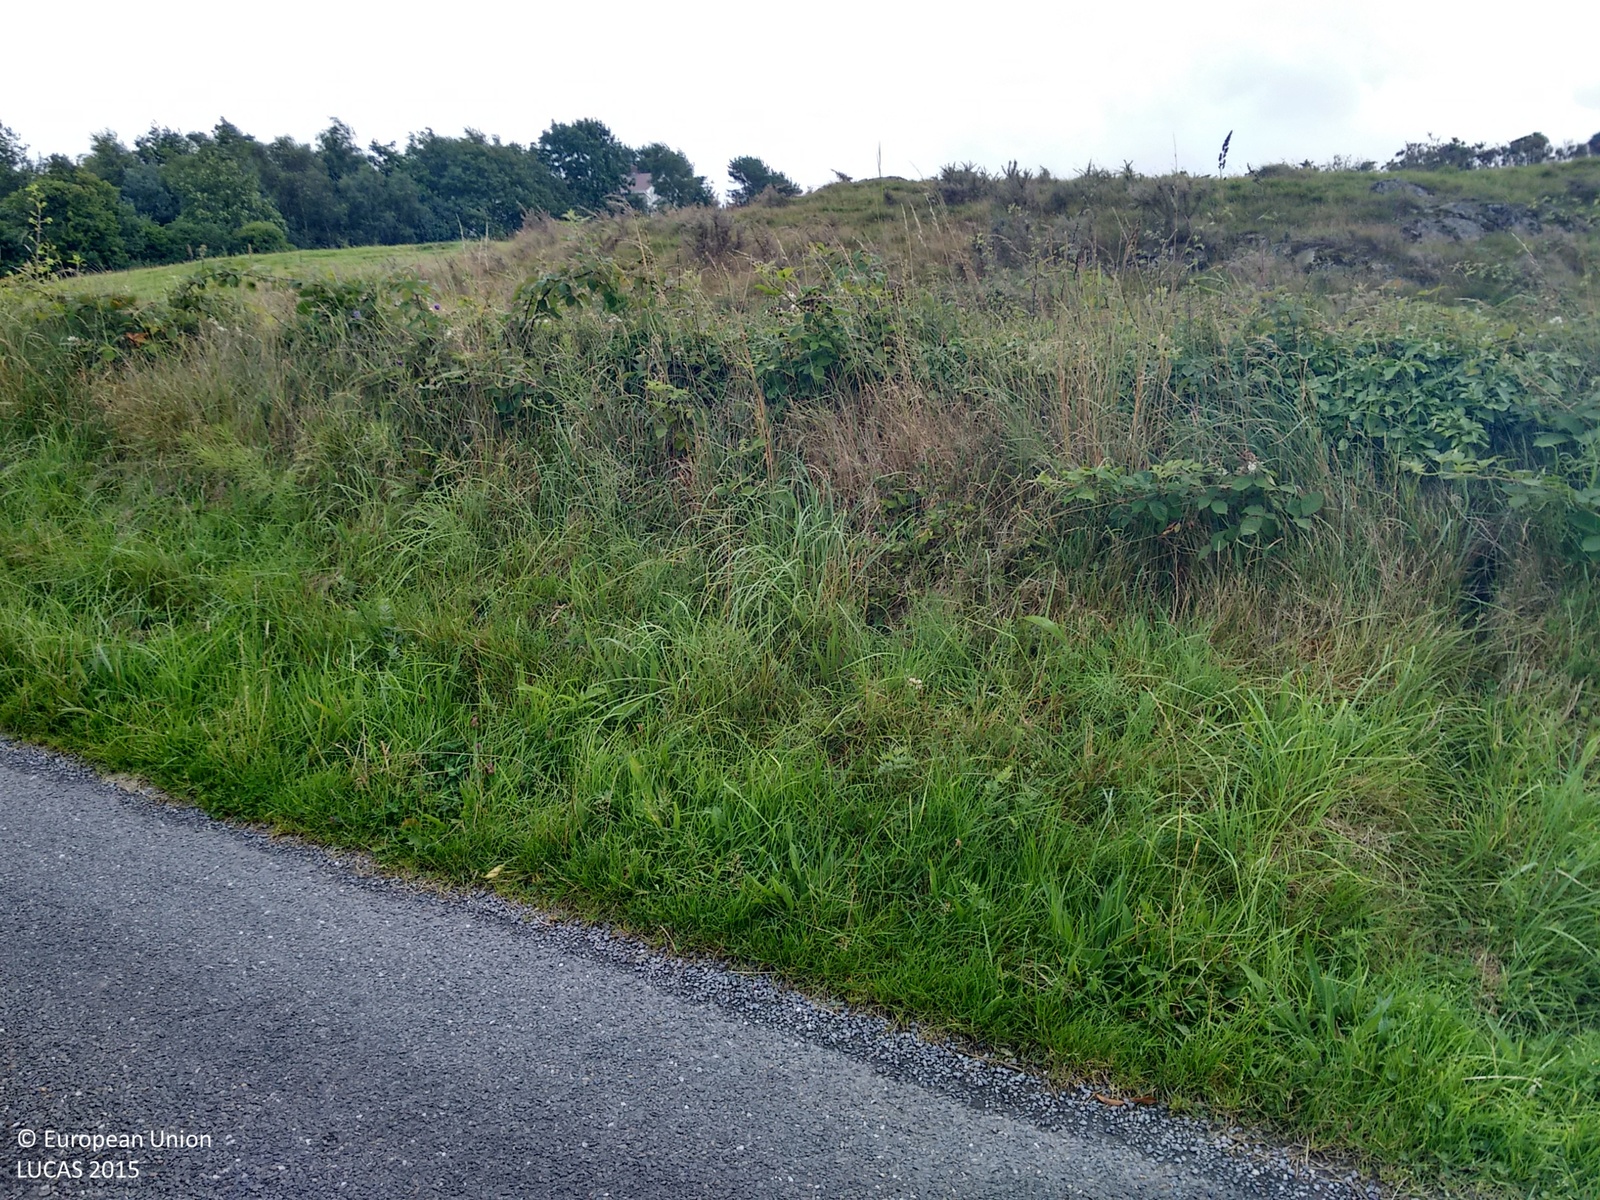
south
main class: Grassland
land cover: Grassland without tree/shrub cover
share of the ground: > 75 %
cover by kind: herbaceous plants 100 %
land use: Agriculture (excluding fallow land and kitchen gardens)
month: August
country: GB
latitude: 54.3784
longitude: -5.7612
